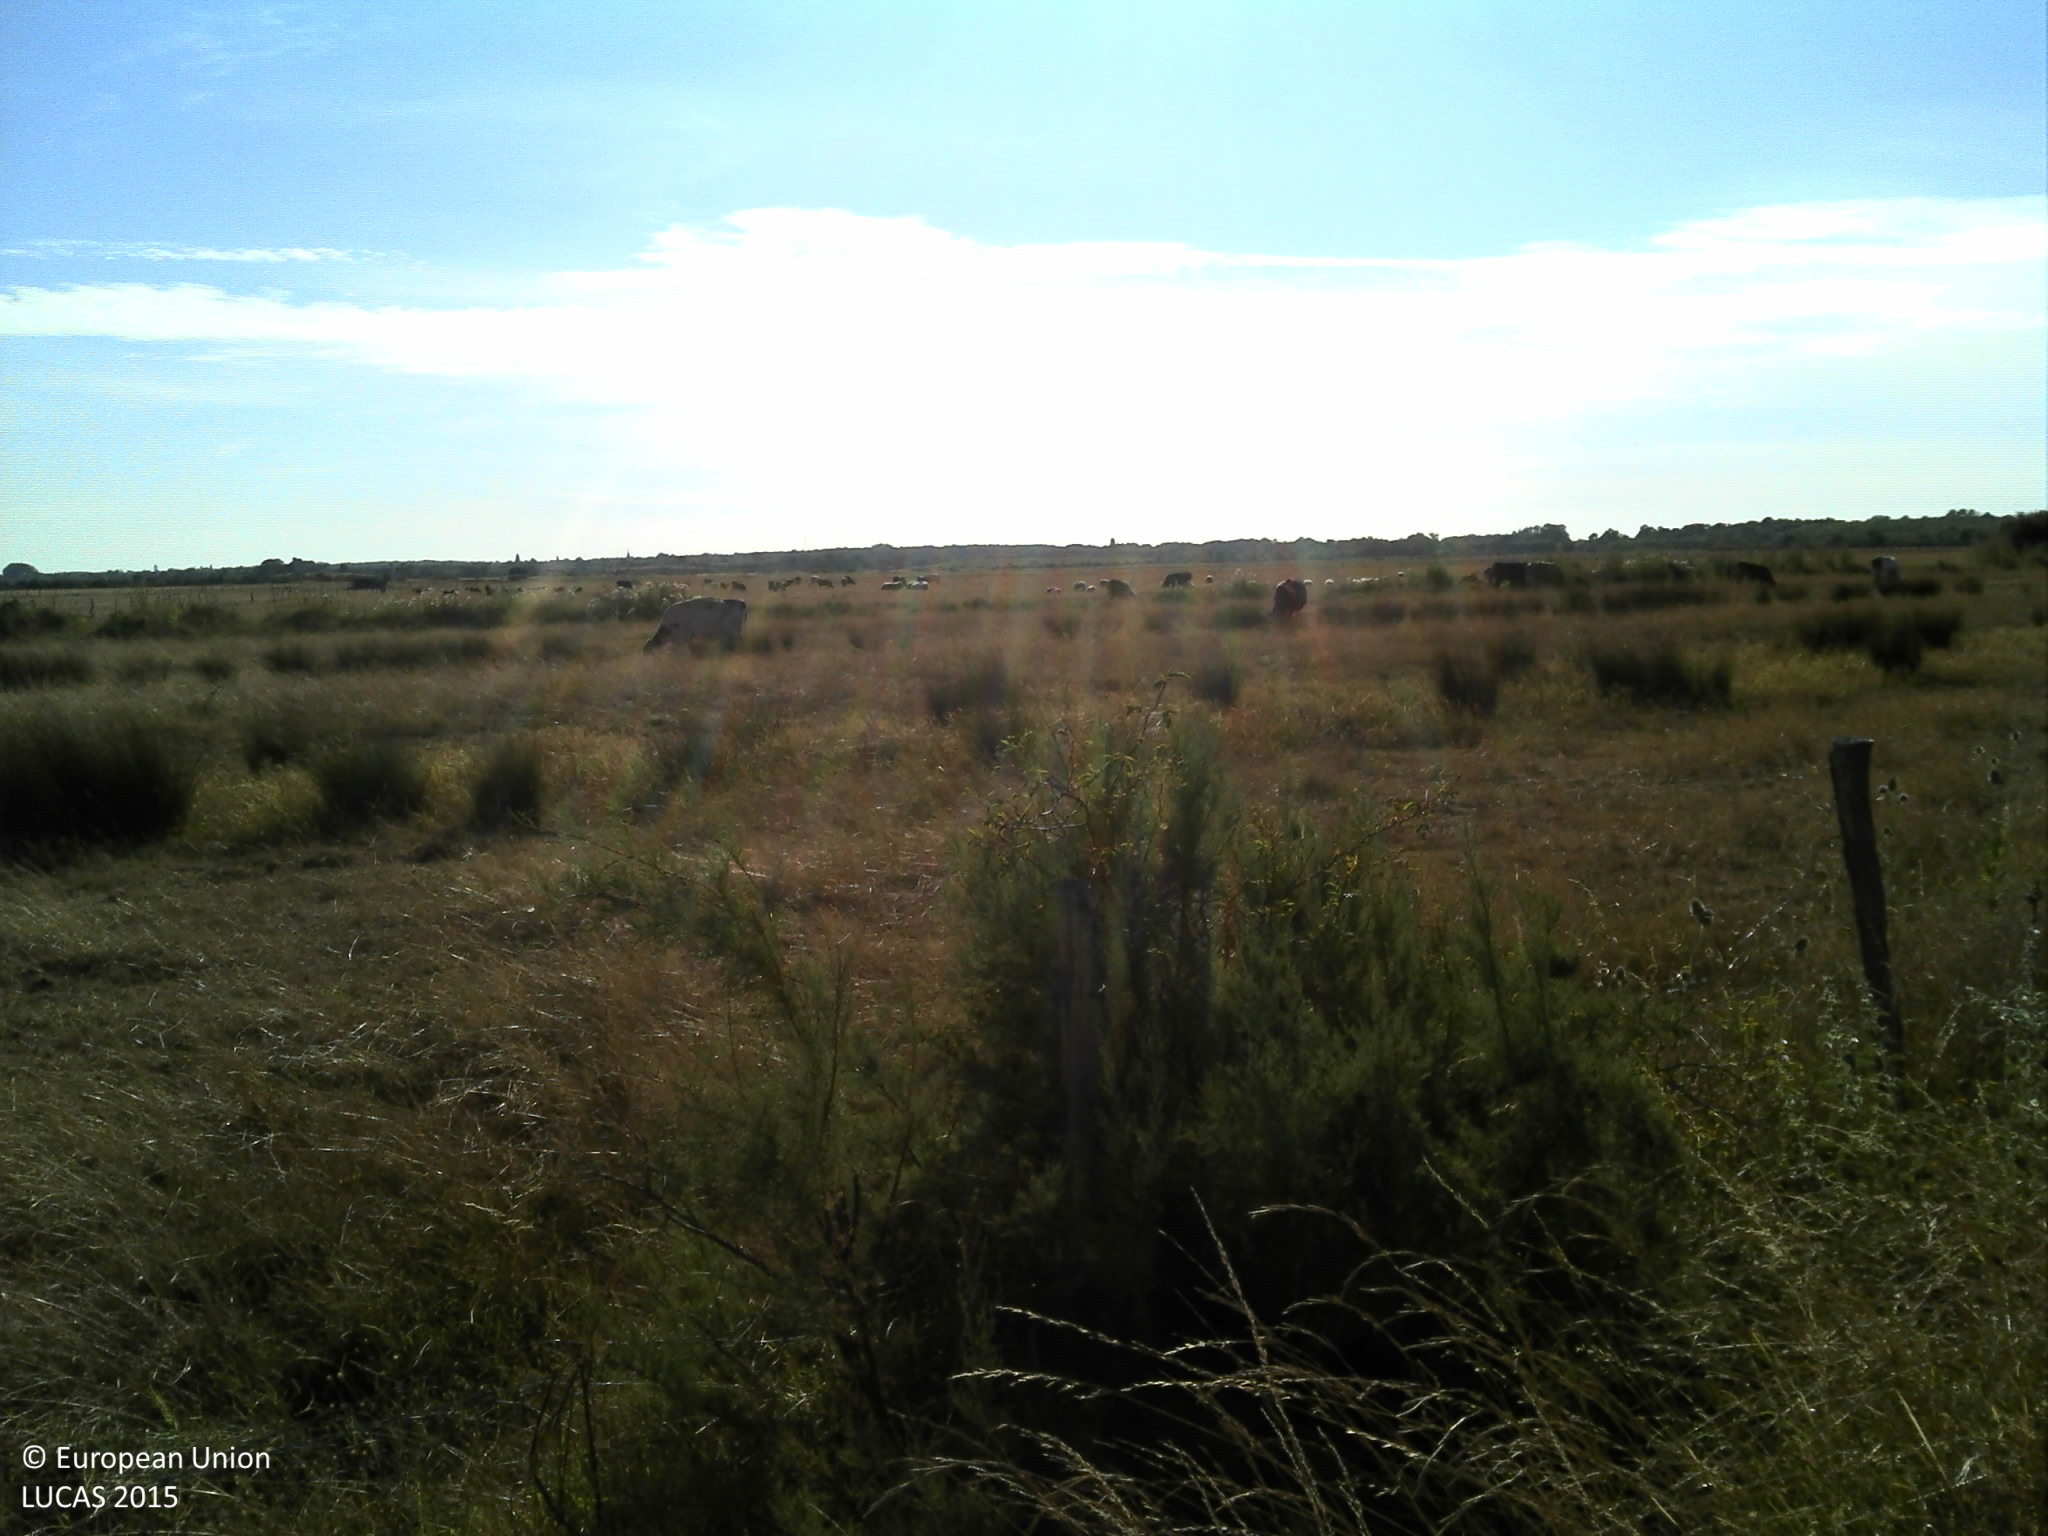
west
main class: Grassland
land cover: Grassland without tree/shrub cover
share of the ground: > 75 %
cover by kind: herbaceous plants 100 %
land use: Agriculture (excluding fallow land and kitchen gardens)
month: July
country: FR
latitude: 45.3120
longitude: -0.8017
